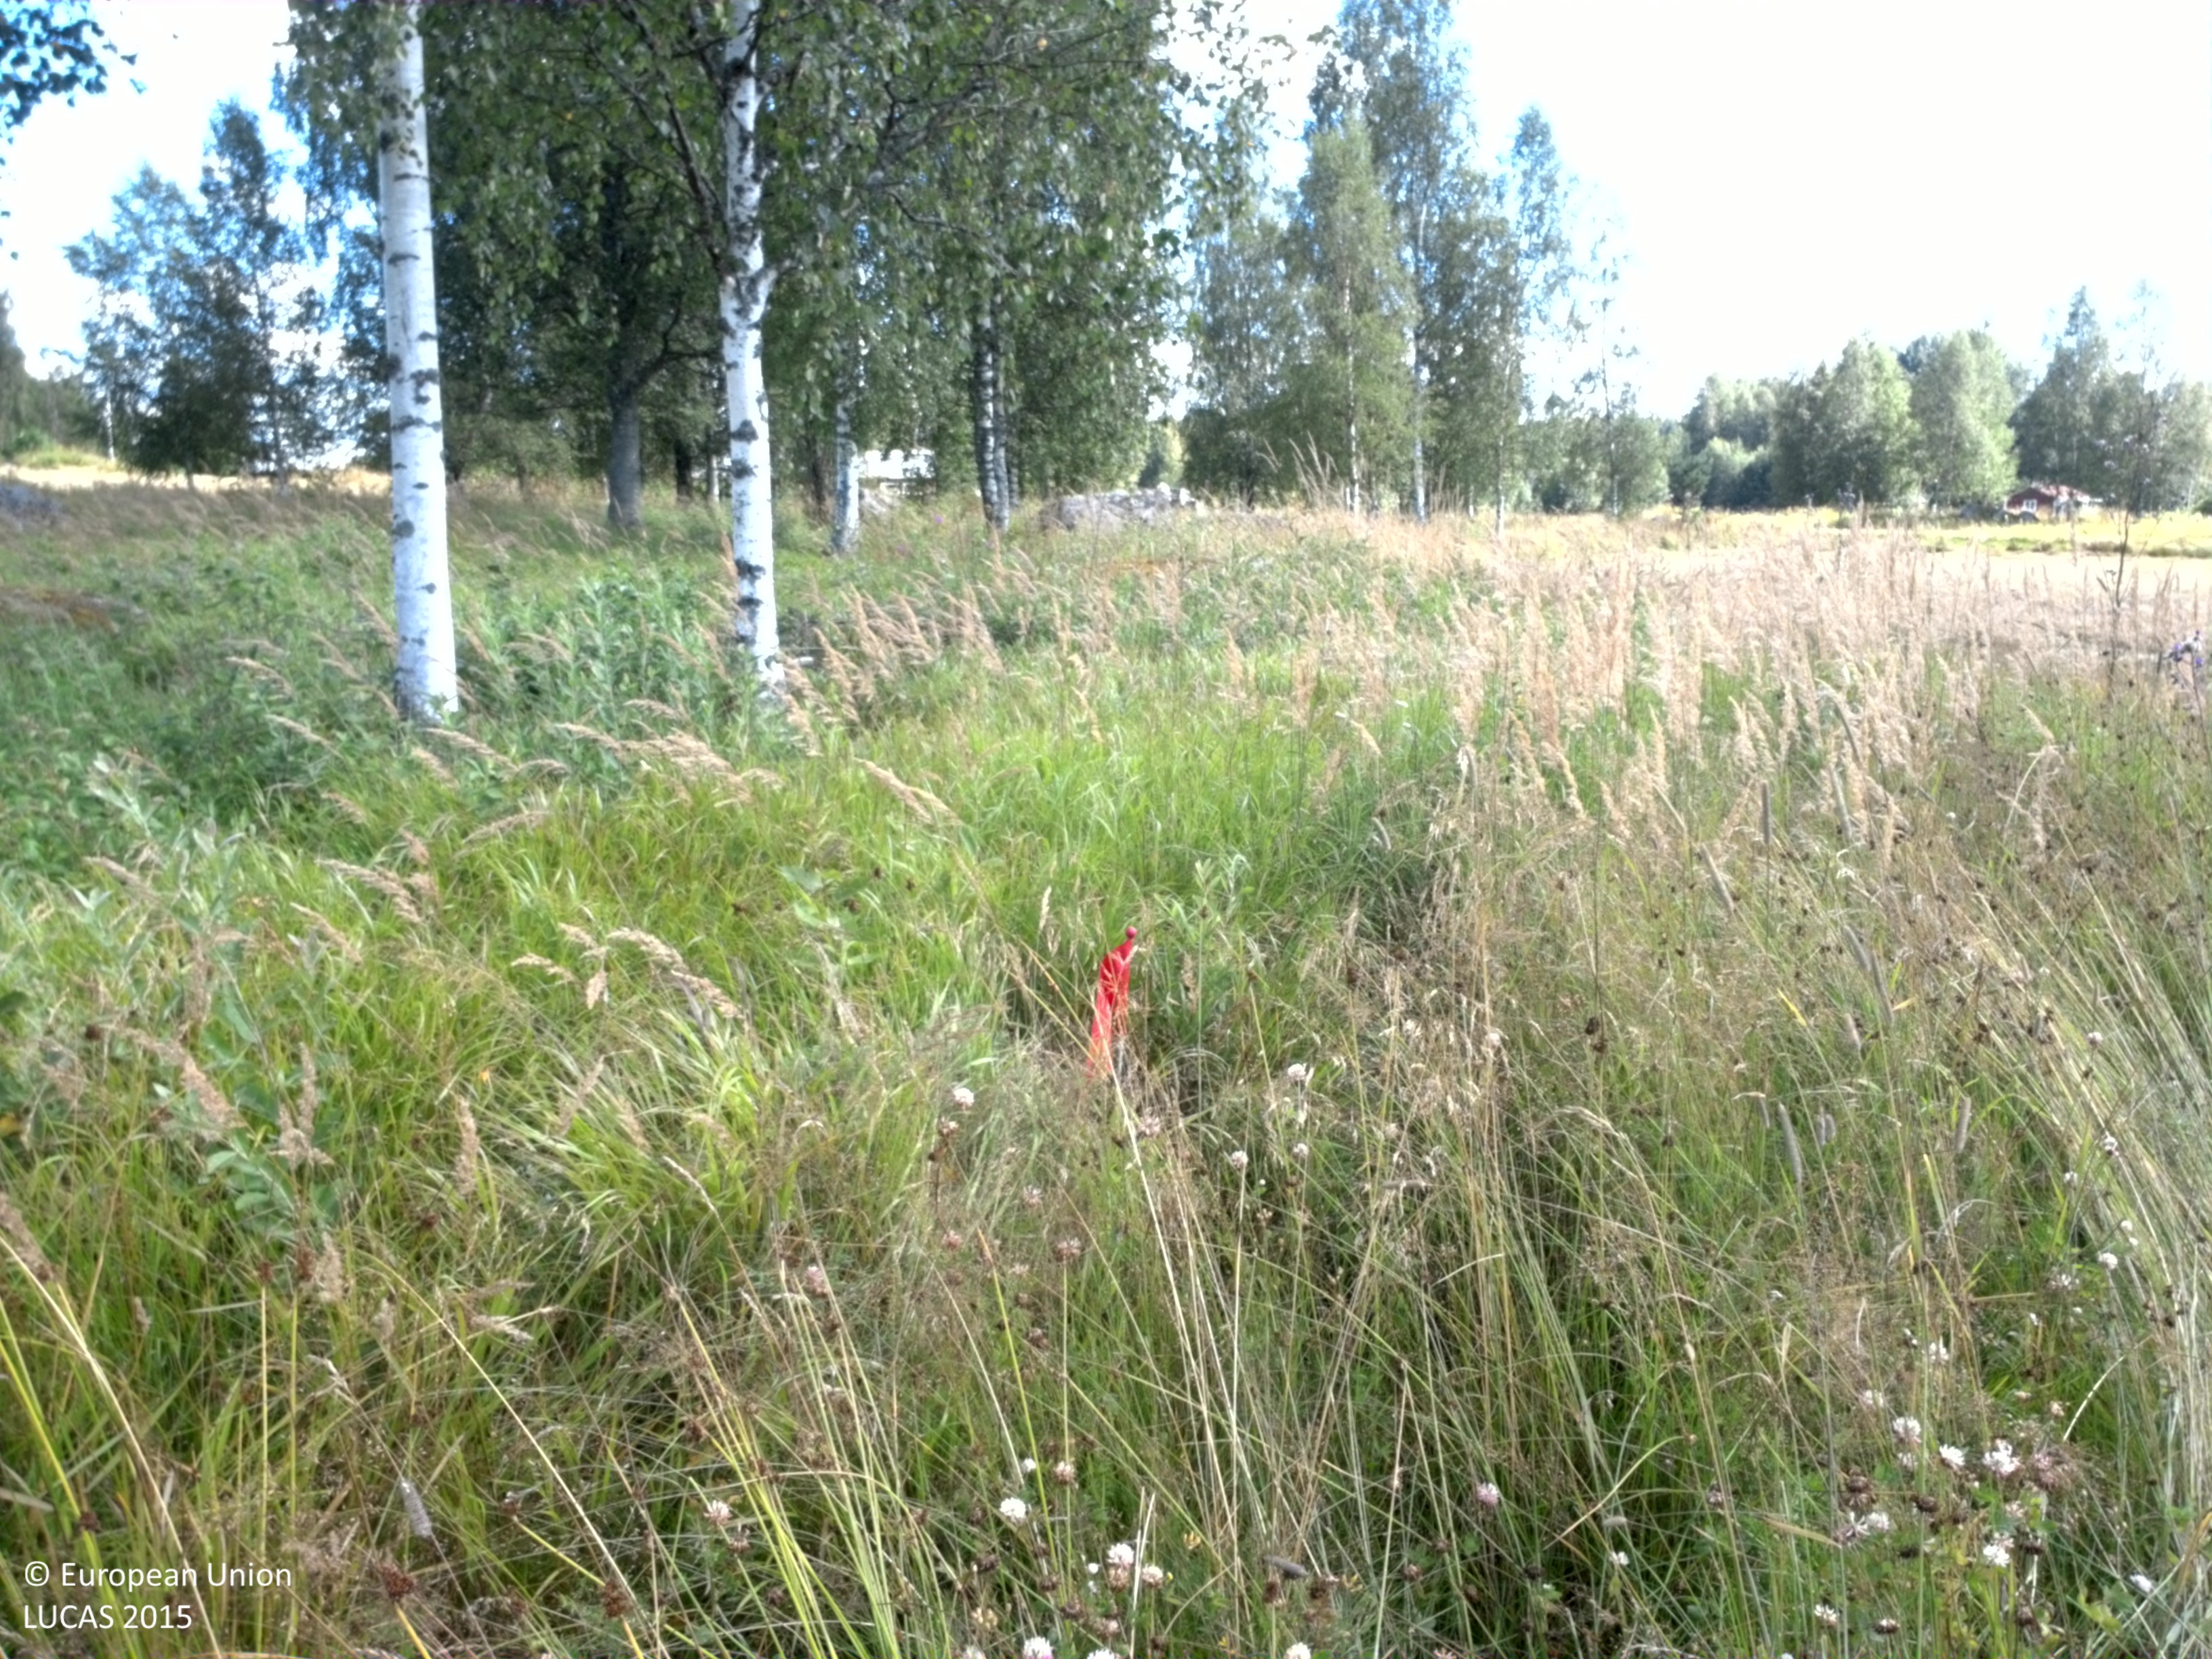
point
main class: Grassland
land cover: Grassland with sparse tree/shrub cover
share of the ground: > 75 %
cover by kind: herbaceous plants 85 %, shrubs 10 %, broadleaved forest trees 5 %
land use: Semi-natural and natural areas not in use
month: August
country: SE
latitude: 60.1758
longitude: 13.3975
